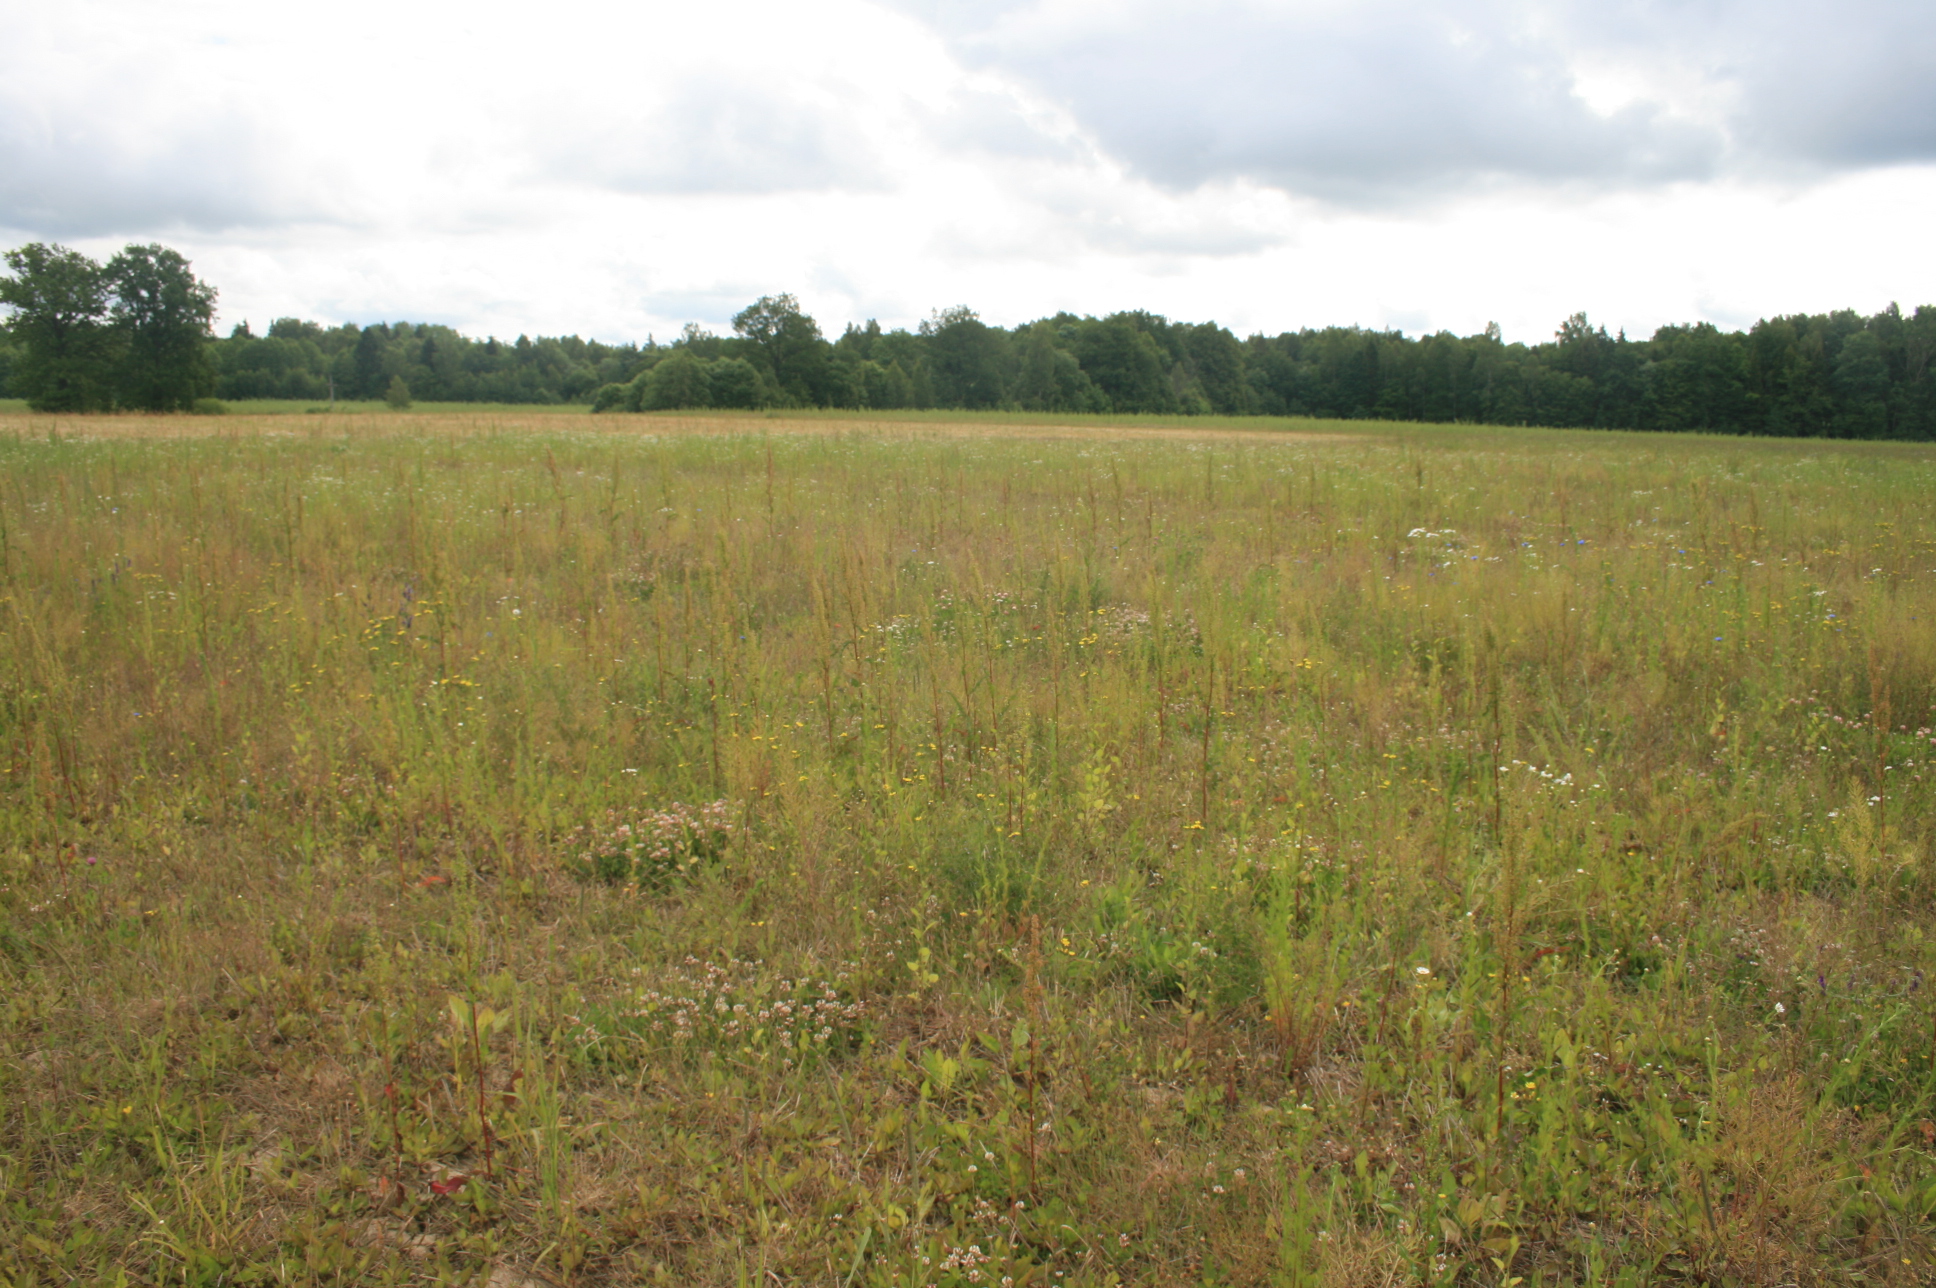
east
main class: Grassland
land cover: Spontaneously vegetated surfaces
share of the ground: > 75 %
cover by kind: herbaceous plants 90 %, unconsolidated bare surface 10 %
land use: Fallow land
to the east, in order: Spontaneously vegetated surfaces; Tracks; Grassland without tree/shrub cover; Tracks; Shruby margins; Permanent industrial crops; Broadleaved woodland
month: June
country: LT
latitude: 55.3582
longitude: 22.2828
